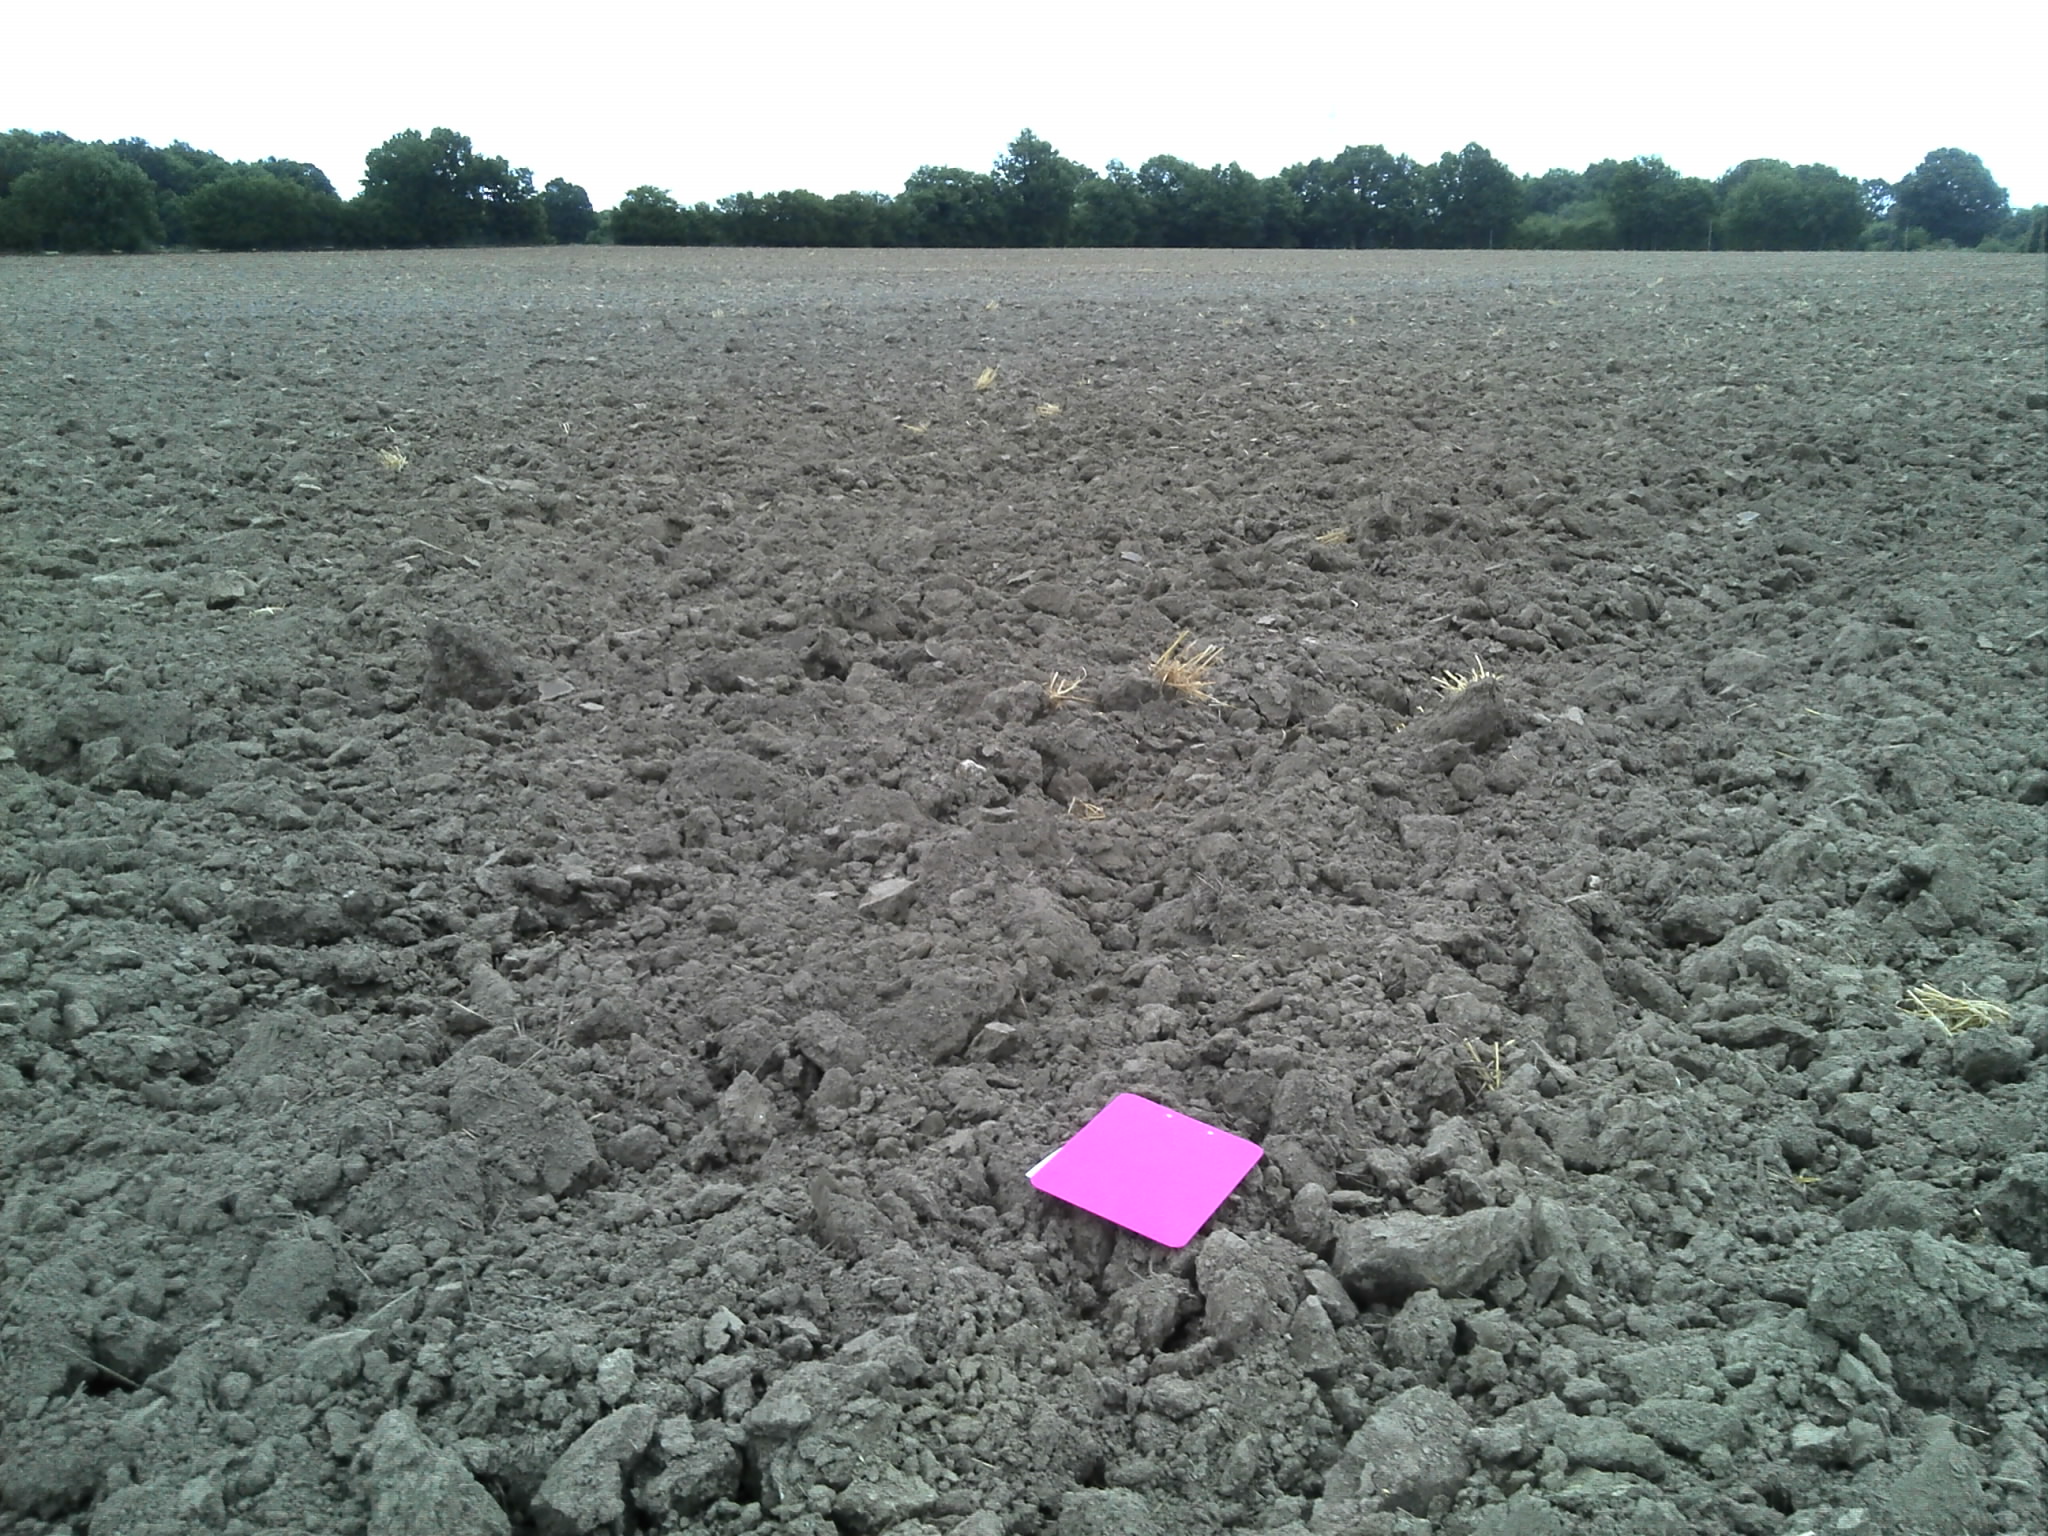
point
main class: Cropland
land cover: Barley
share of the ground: < 10 %
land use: Agriculture (excluding fallow land and kitchen gardens)
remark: Harvested field
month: July
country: FR
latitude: 46.7066
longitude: 1.5791
